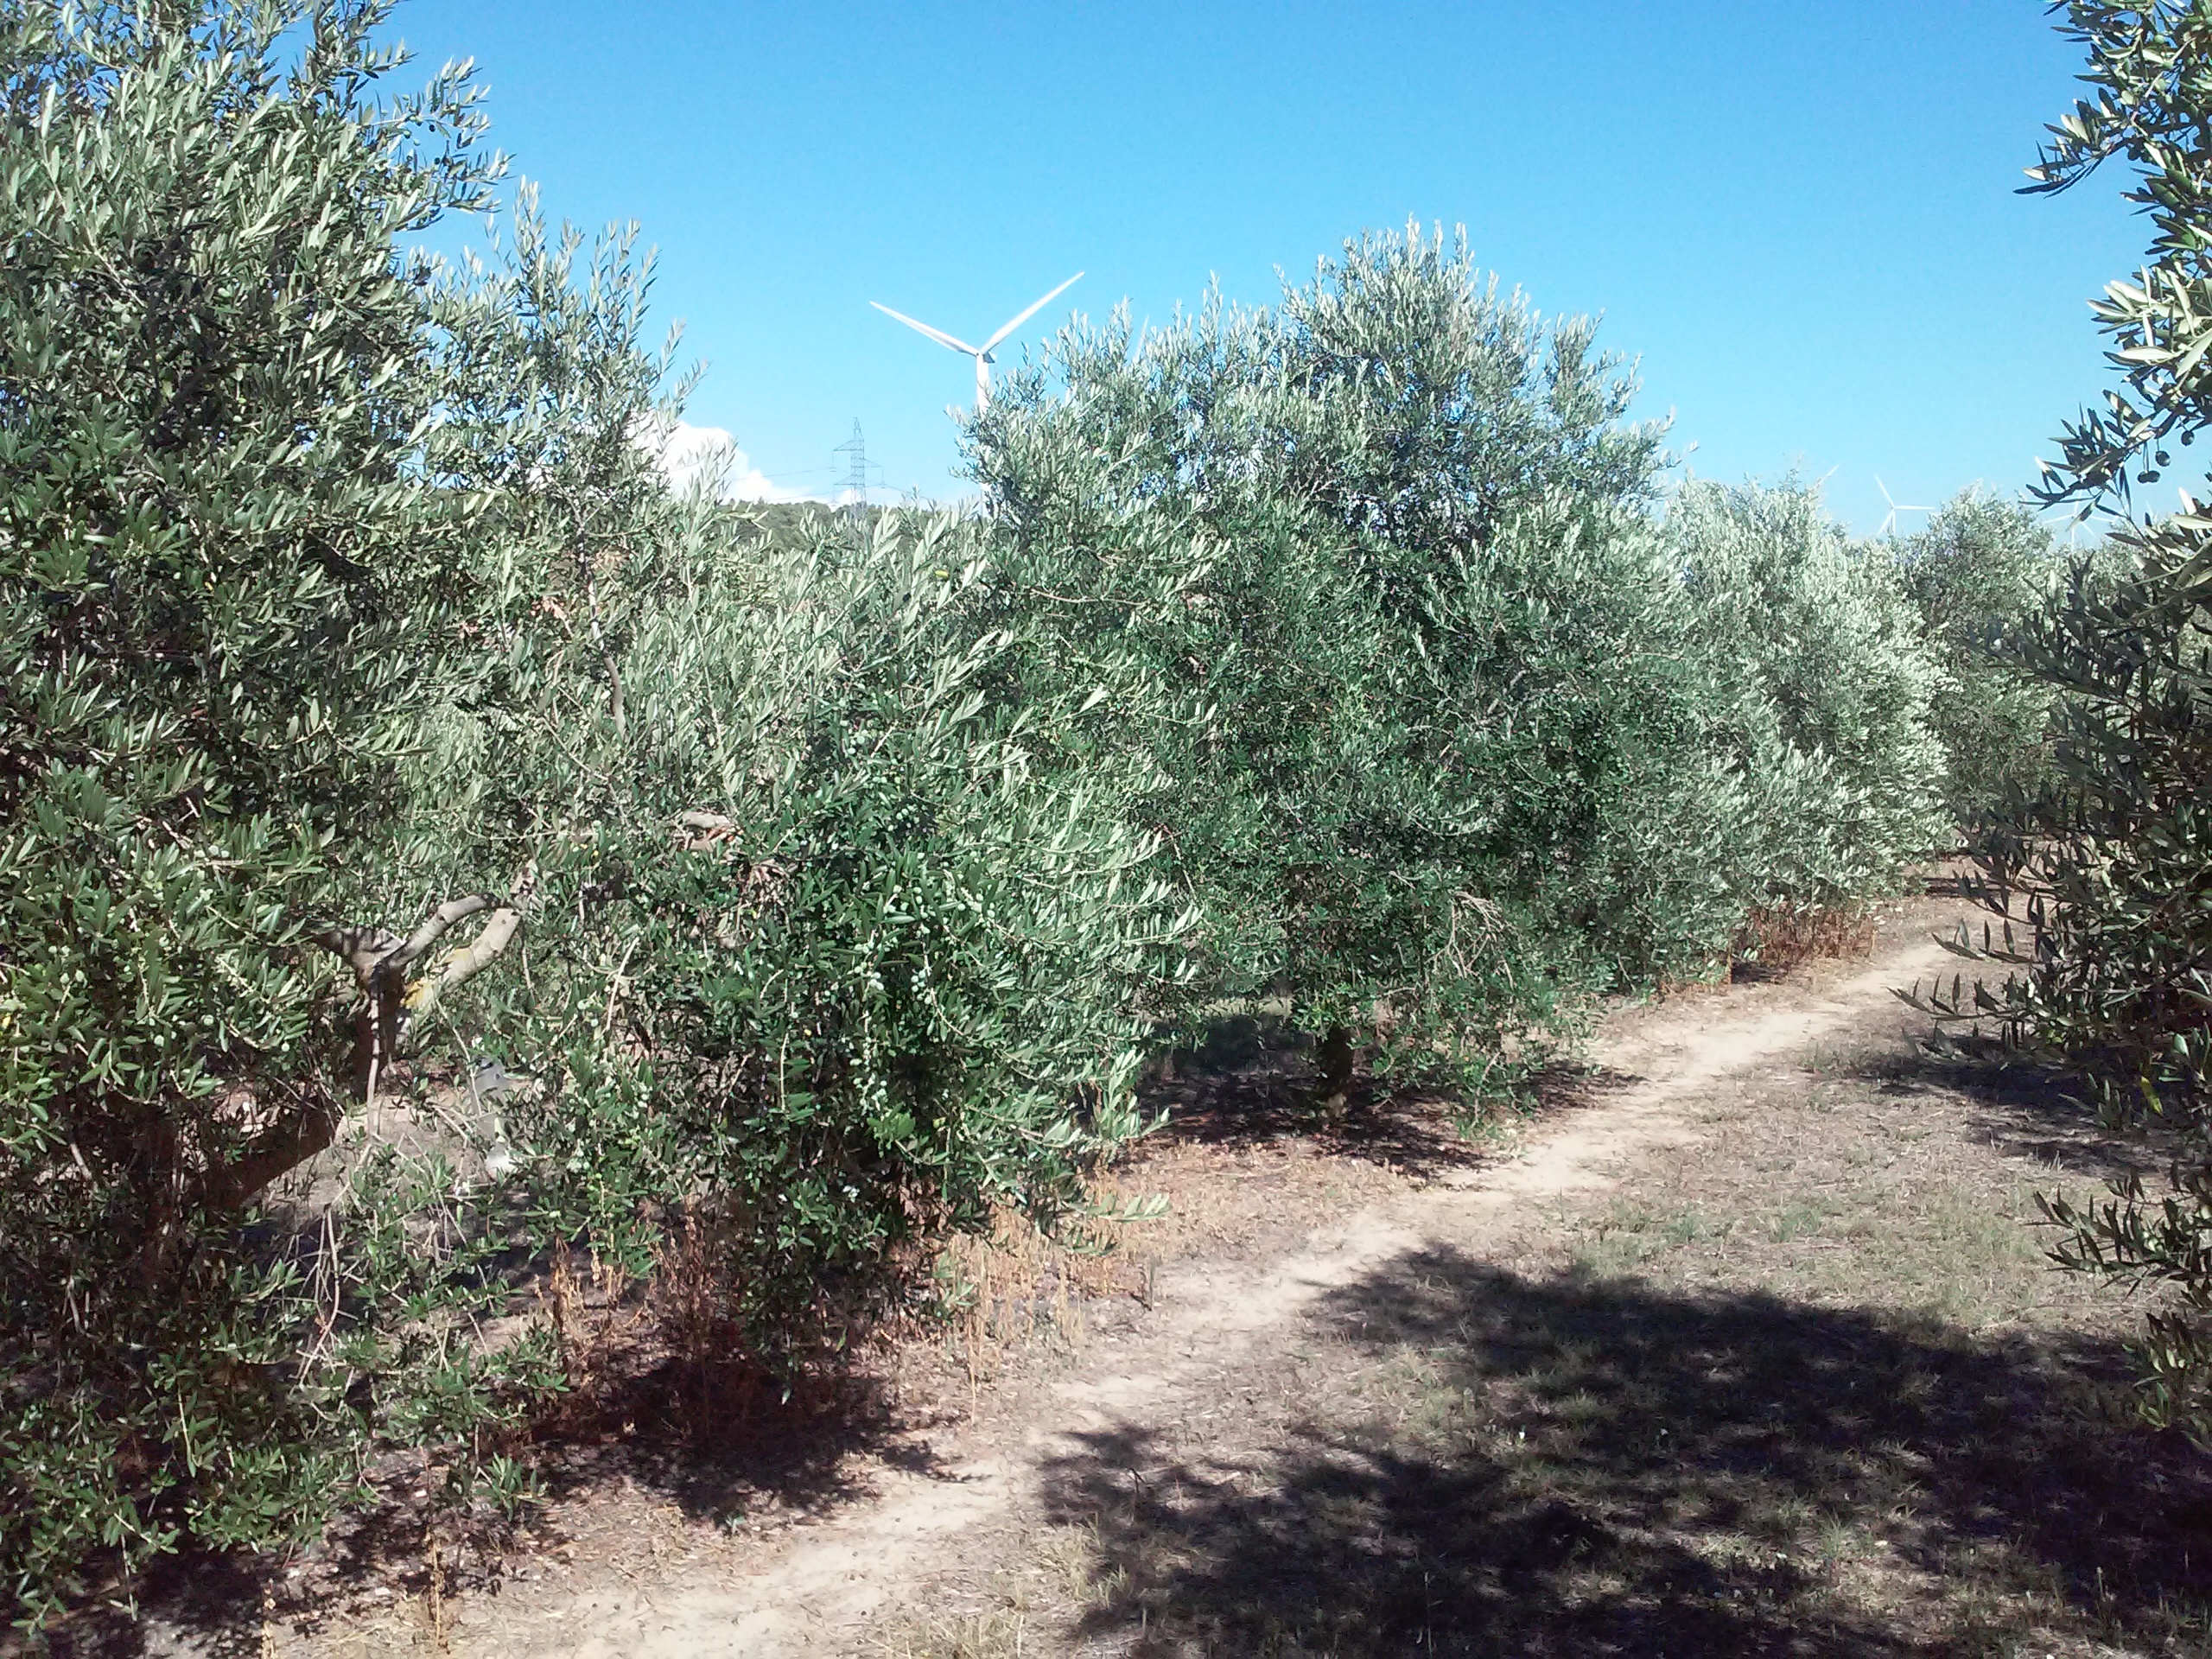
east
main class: Cropland
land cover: Olive groves
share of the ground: 25 - 50 %
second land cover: Other bare soil
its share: > 75 %
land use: Agriculture (excluding fallow land and kitchen gardens)
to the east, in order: Olive groves; Other bare soil; Tracks; Dry stone walls; Nuts trees
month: August
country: ES
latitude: 41.3824
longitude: 0.6265
